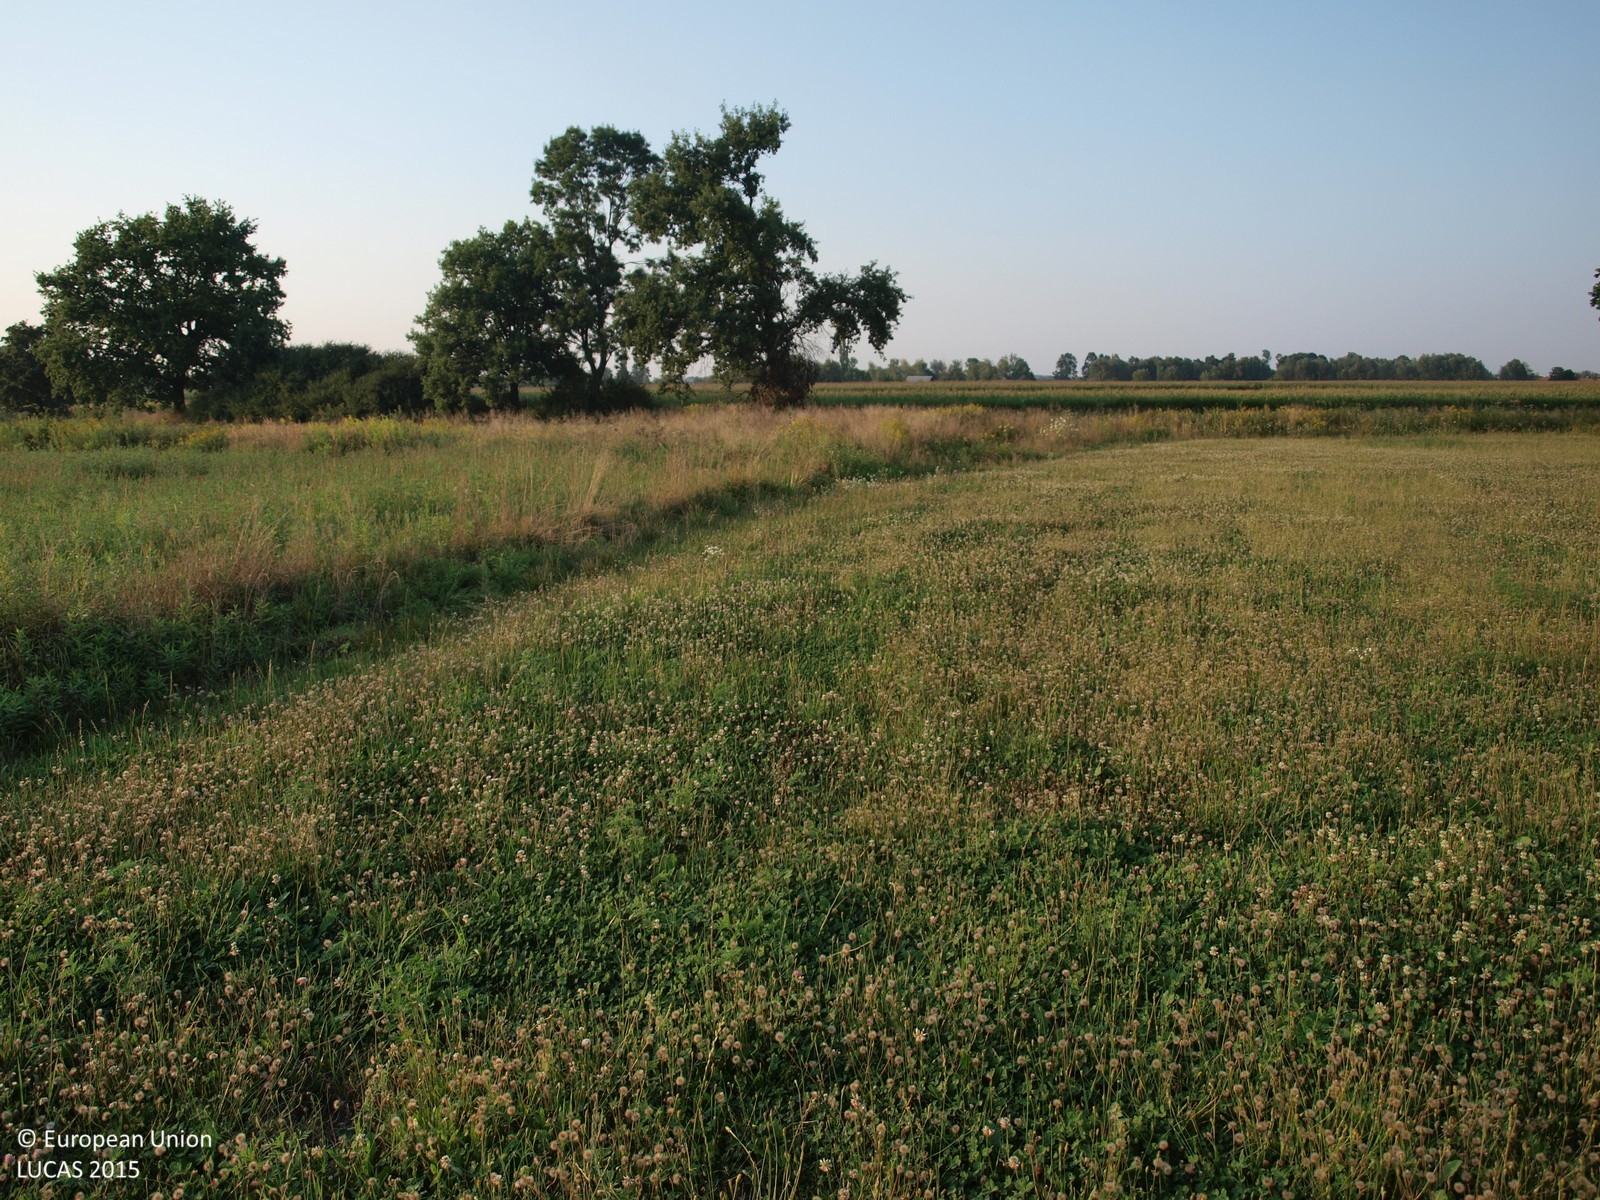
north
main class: Grassland
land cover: Grassland without tree/shrub cover
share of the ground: > 75 %
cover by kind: herbaceous plants 100 %
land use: Agriculture (excluding fallow land and kitchen gardens)
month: August
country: HR
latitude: 45.8282
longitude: 16.4999
